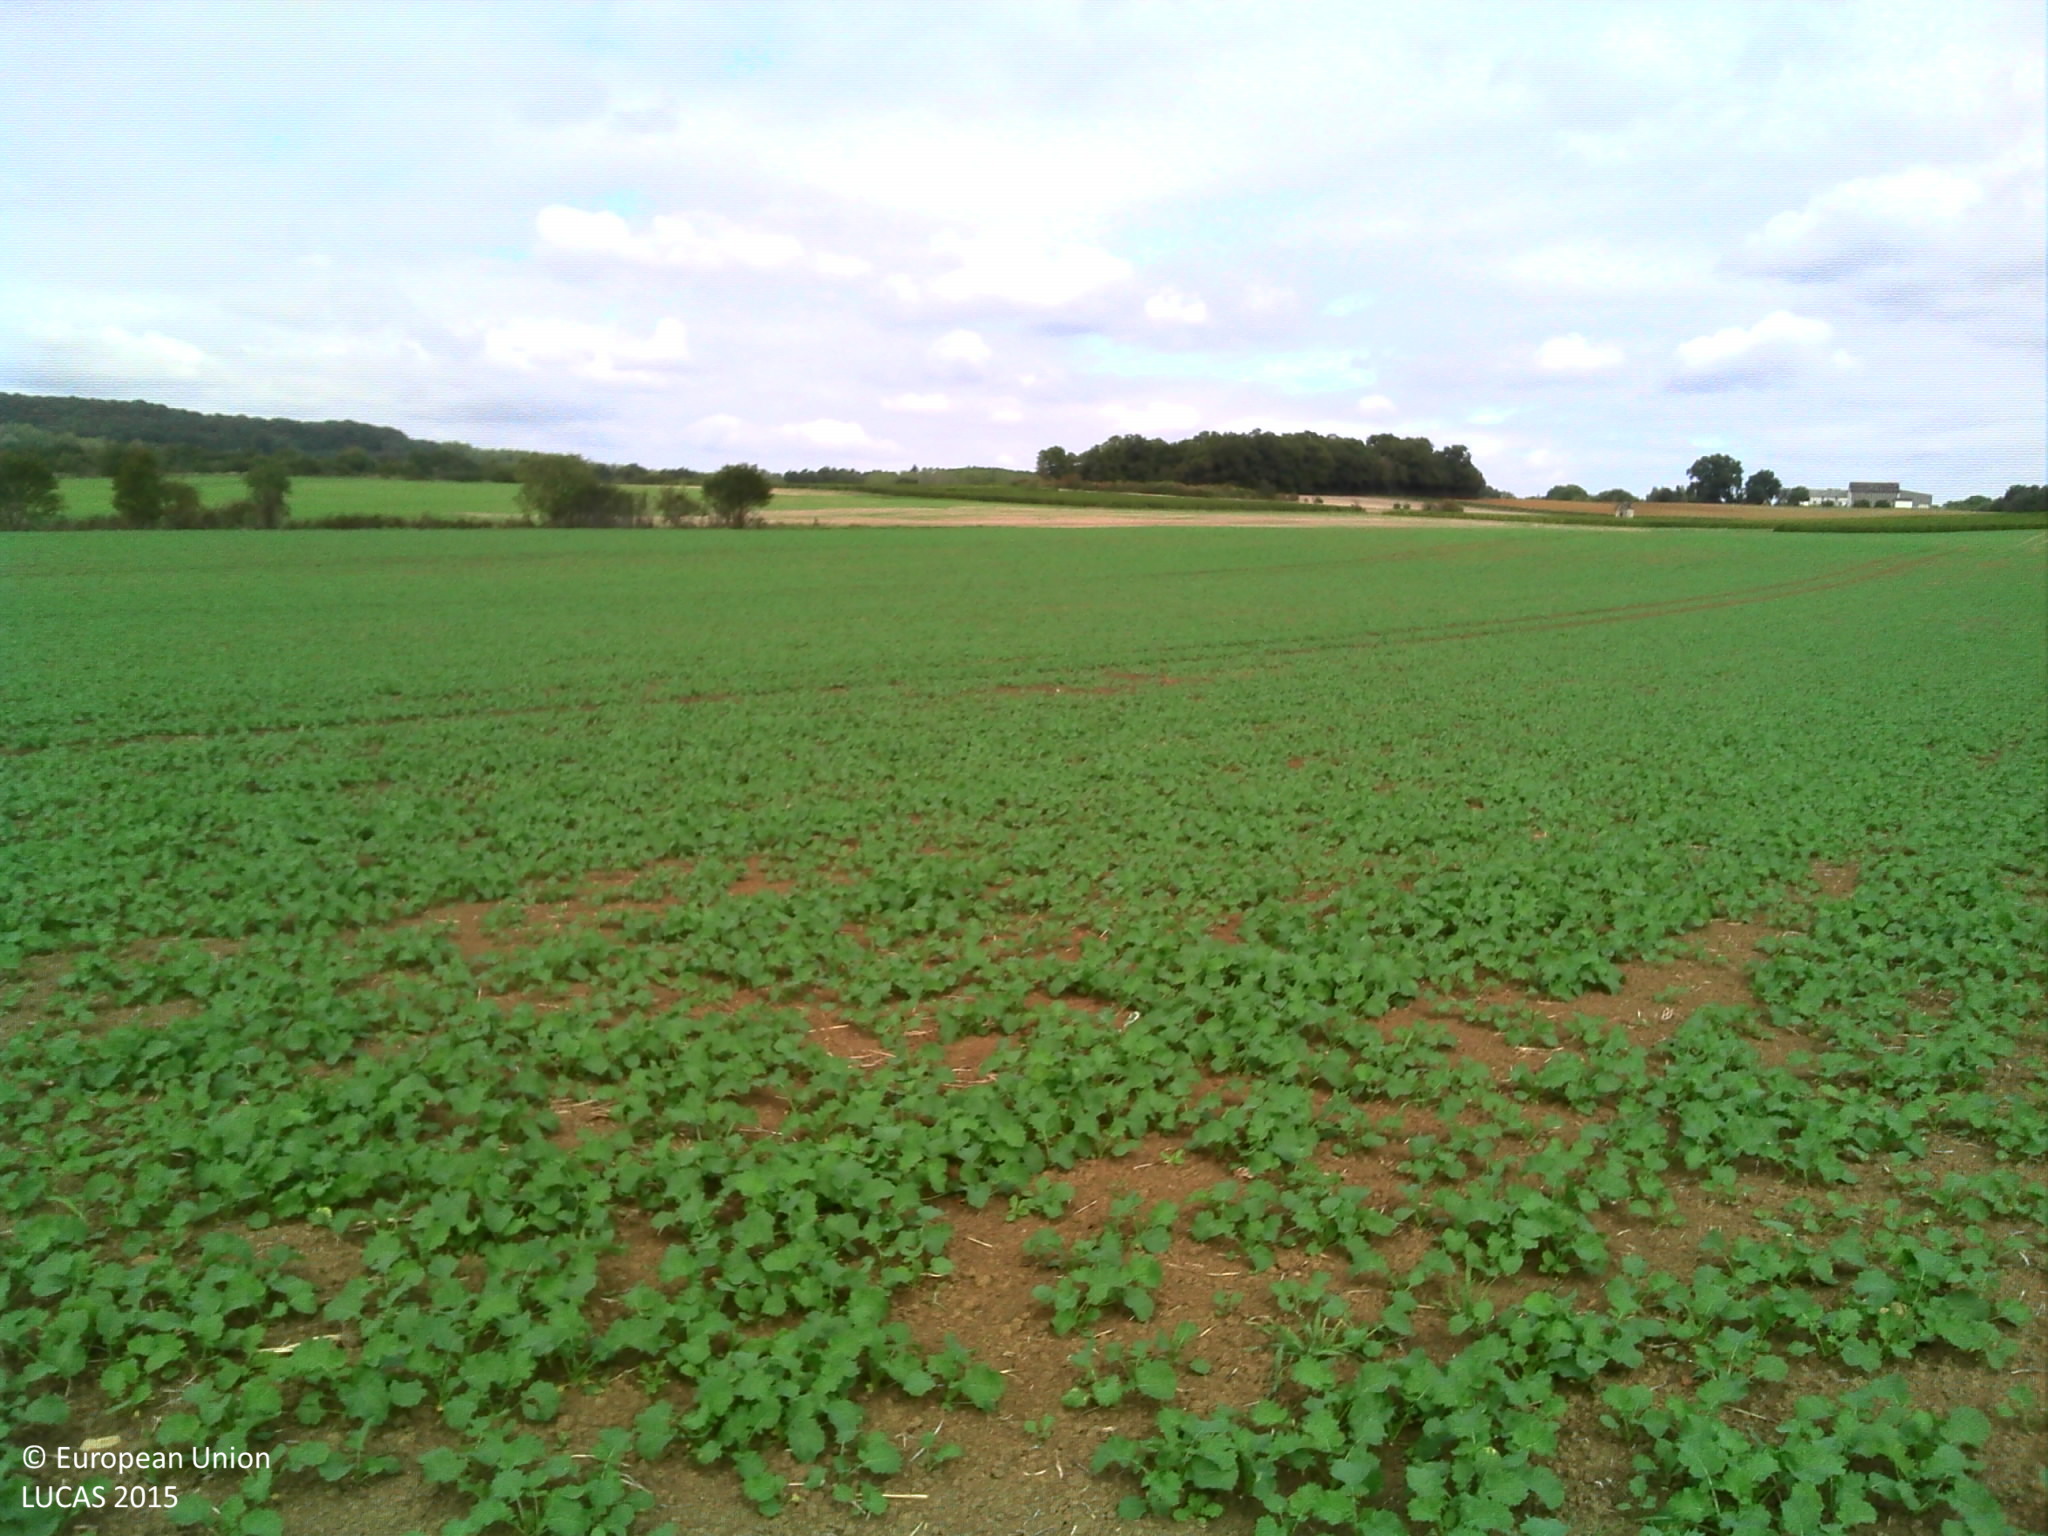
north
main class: Cropland
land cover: Rape and turnip rape
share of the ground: > 75 %
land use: Agriculture (excluding fallow land and kitchen gardens)
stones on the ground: < 10 %
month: June
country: FR
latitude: 47.2326
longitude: 2.5832
